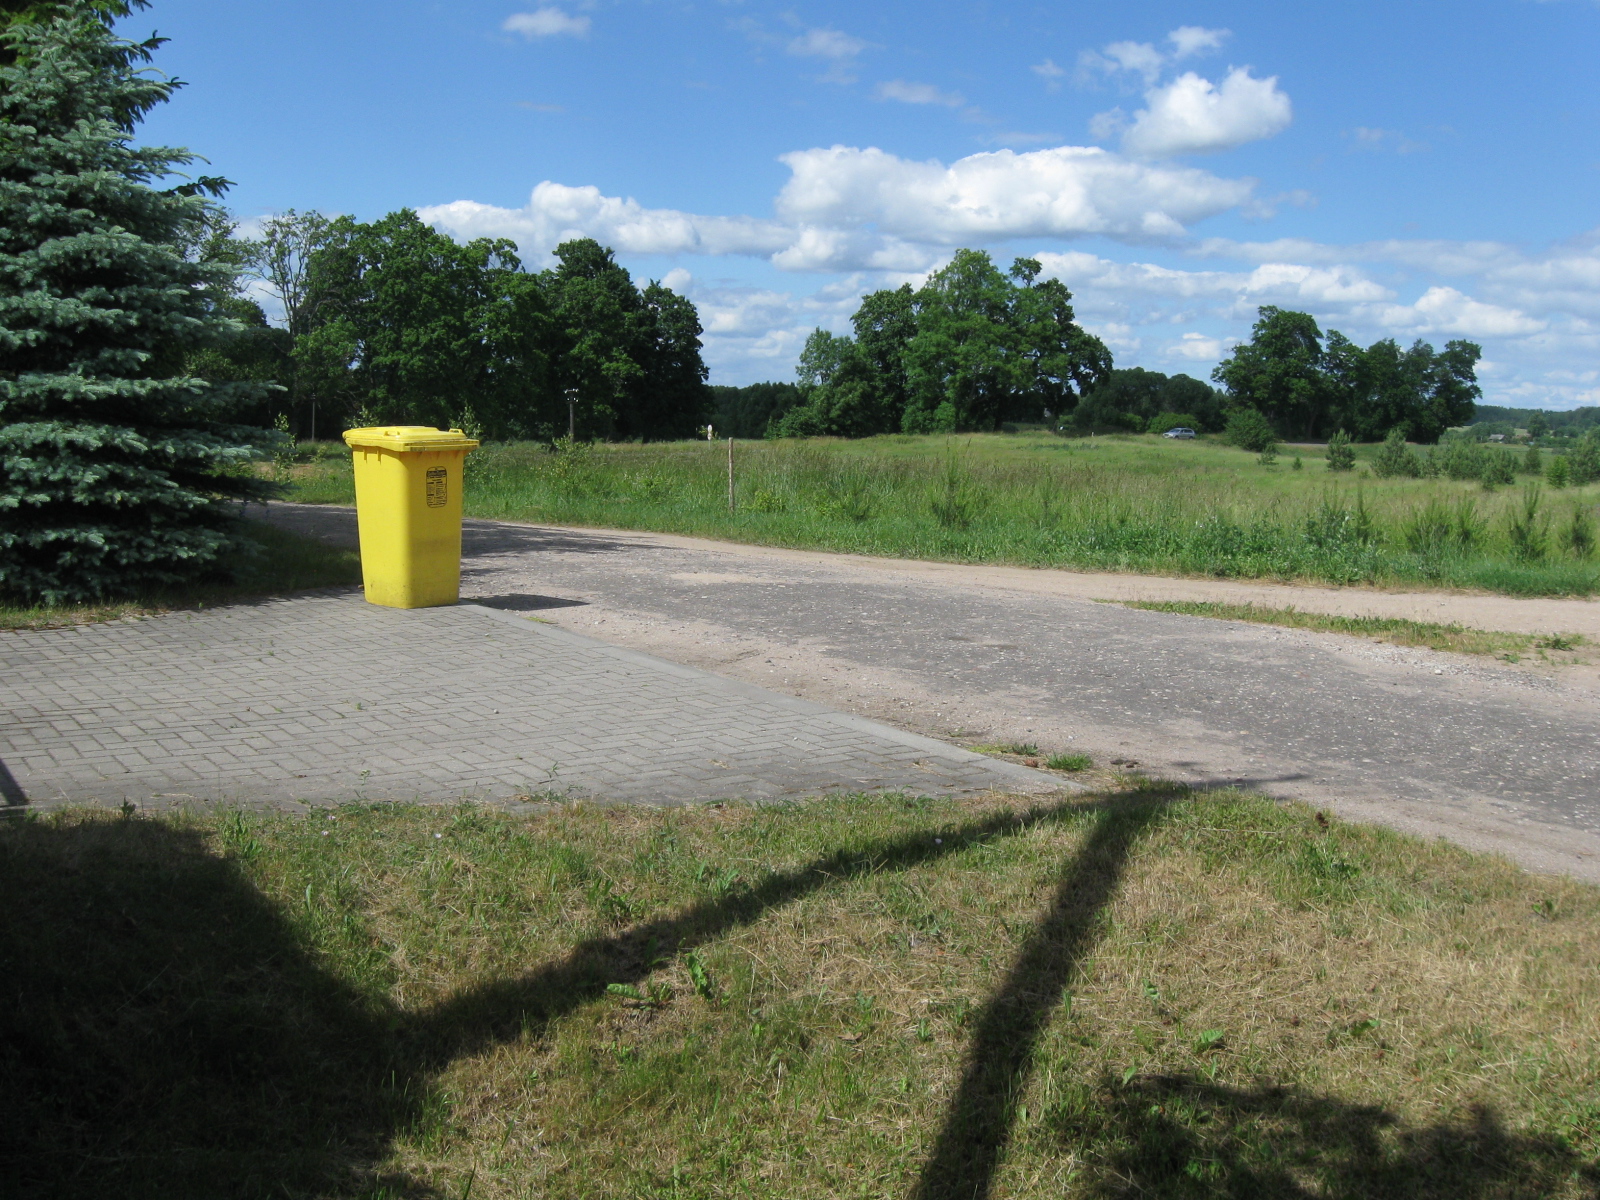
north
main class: Grassland
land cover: Grassland without tree/shrub cover
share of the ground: > 75 %
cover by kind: herbaceous plants 100 %
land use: Residential
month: June
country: LT
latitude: 54.4860
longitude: 24.5999
